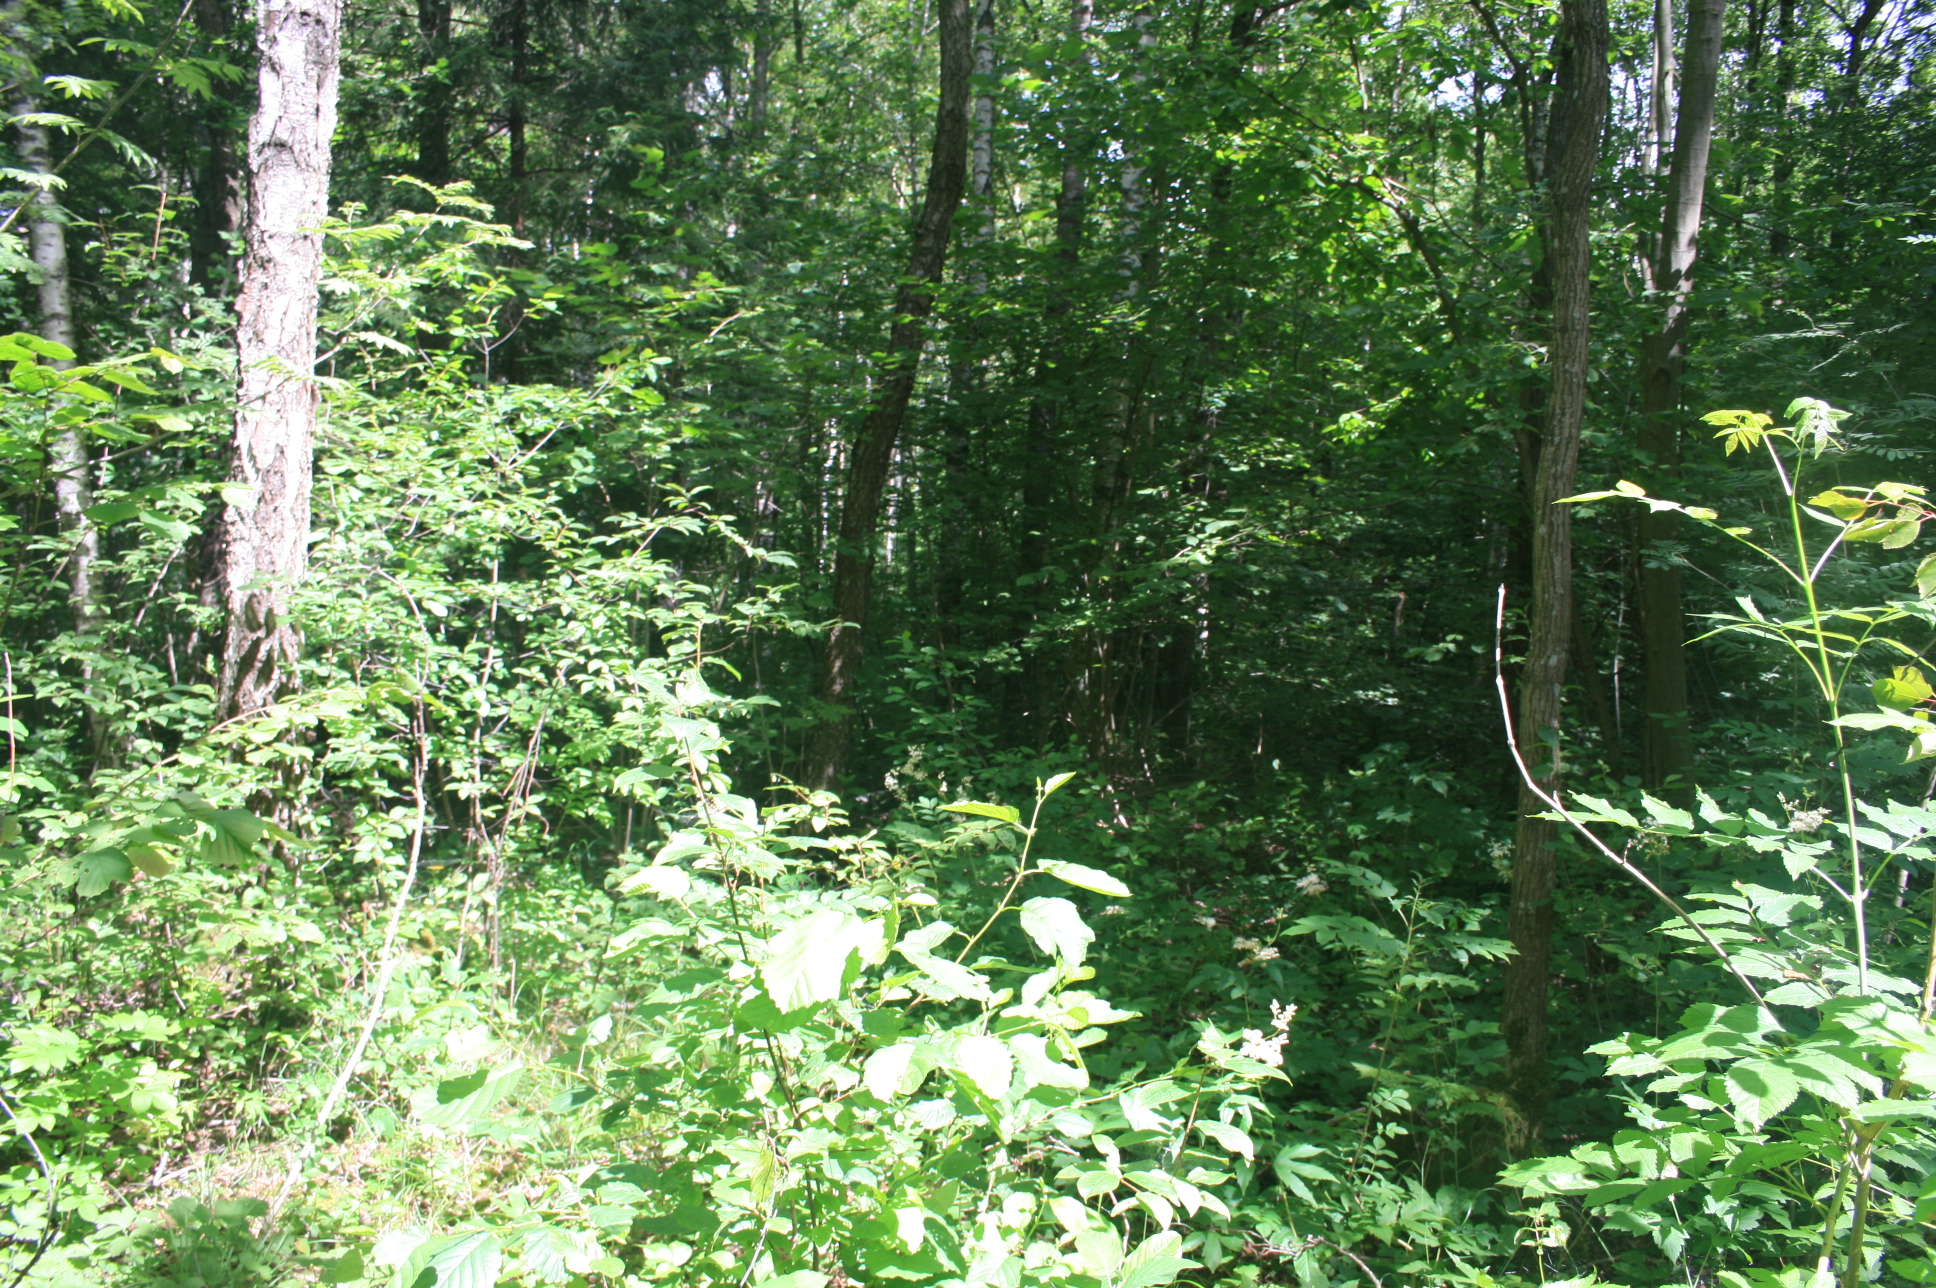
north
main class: Woodland
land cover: Broadleaved woodland
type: non-riverine alder, birch or aspen forest
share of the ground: > 75 %
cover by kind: broadleaved forest trees 90 %, shrubs 5 %, herbaceous plants 5 %
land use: Forestry
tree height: > 5 m
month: July
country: LT
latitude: 55.7857
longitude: 21.4135
